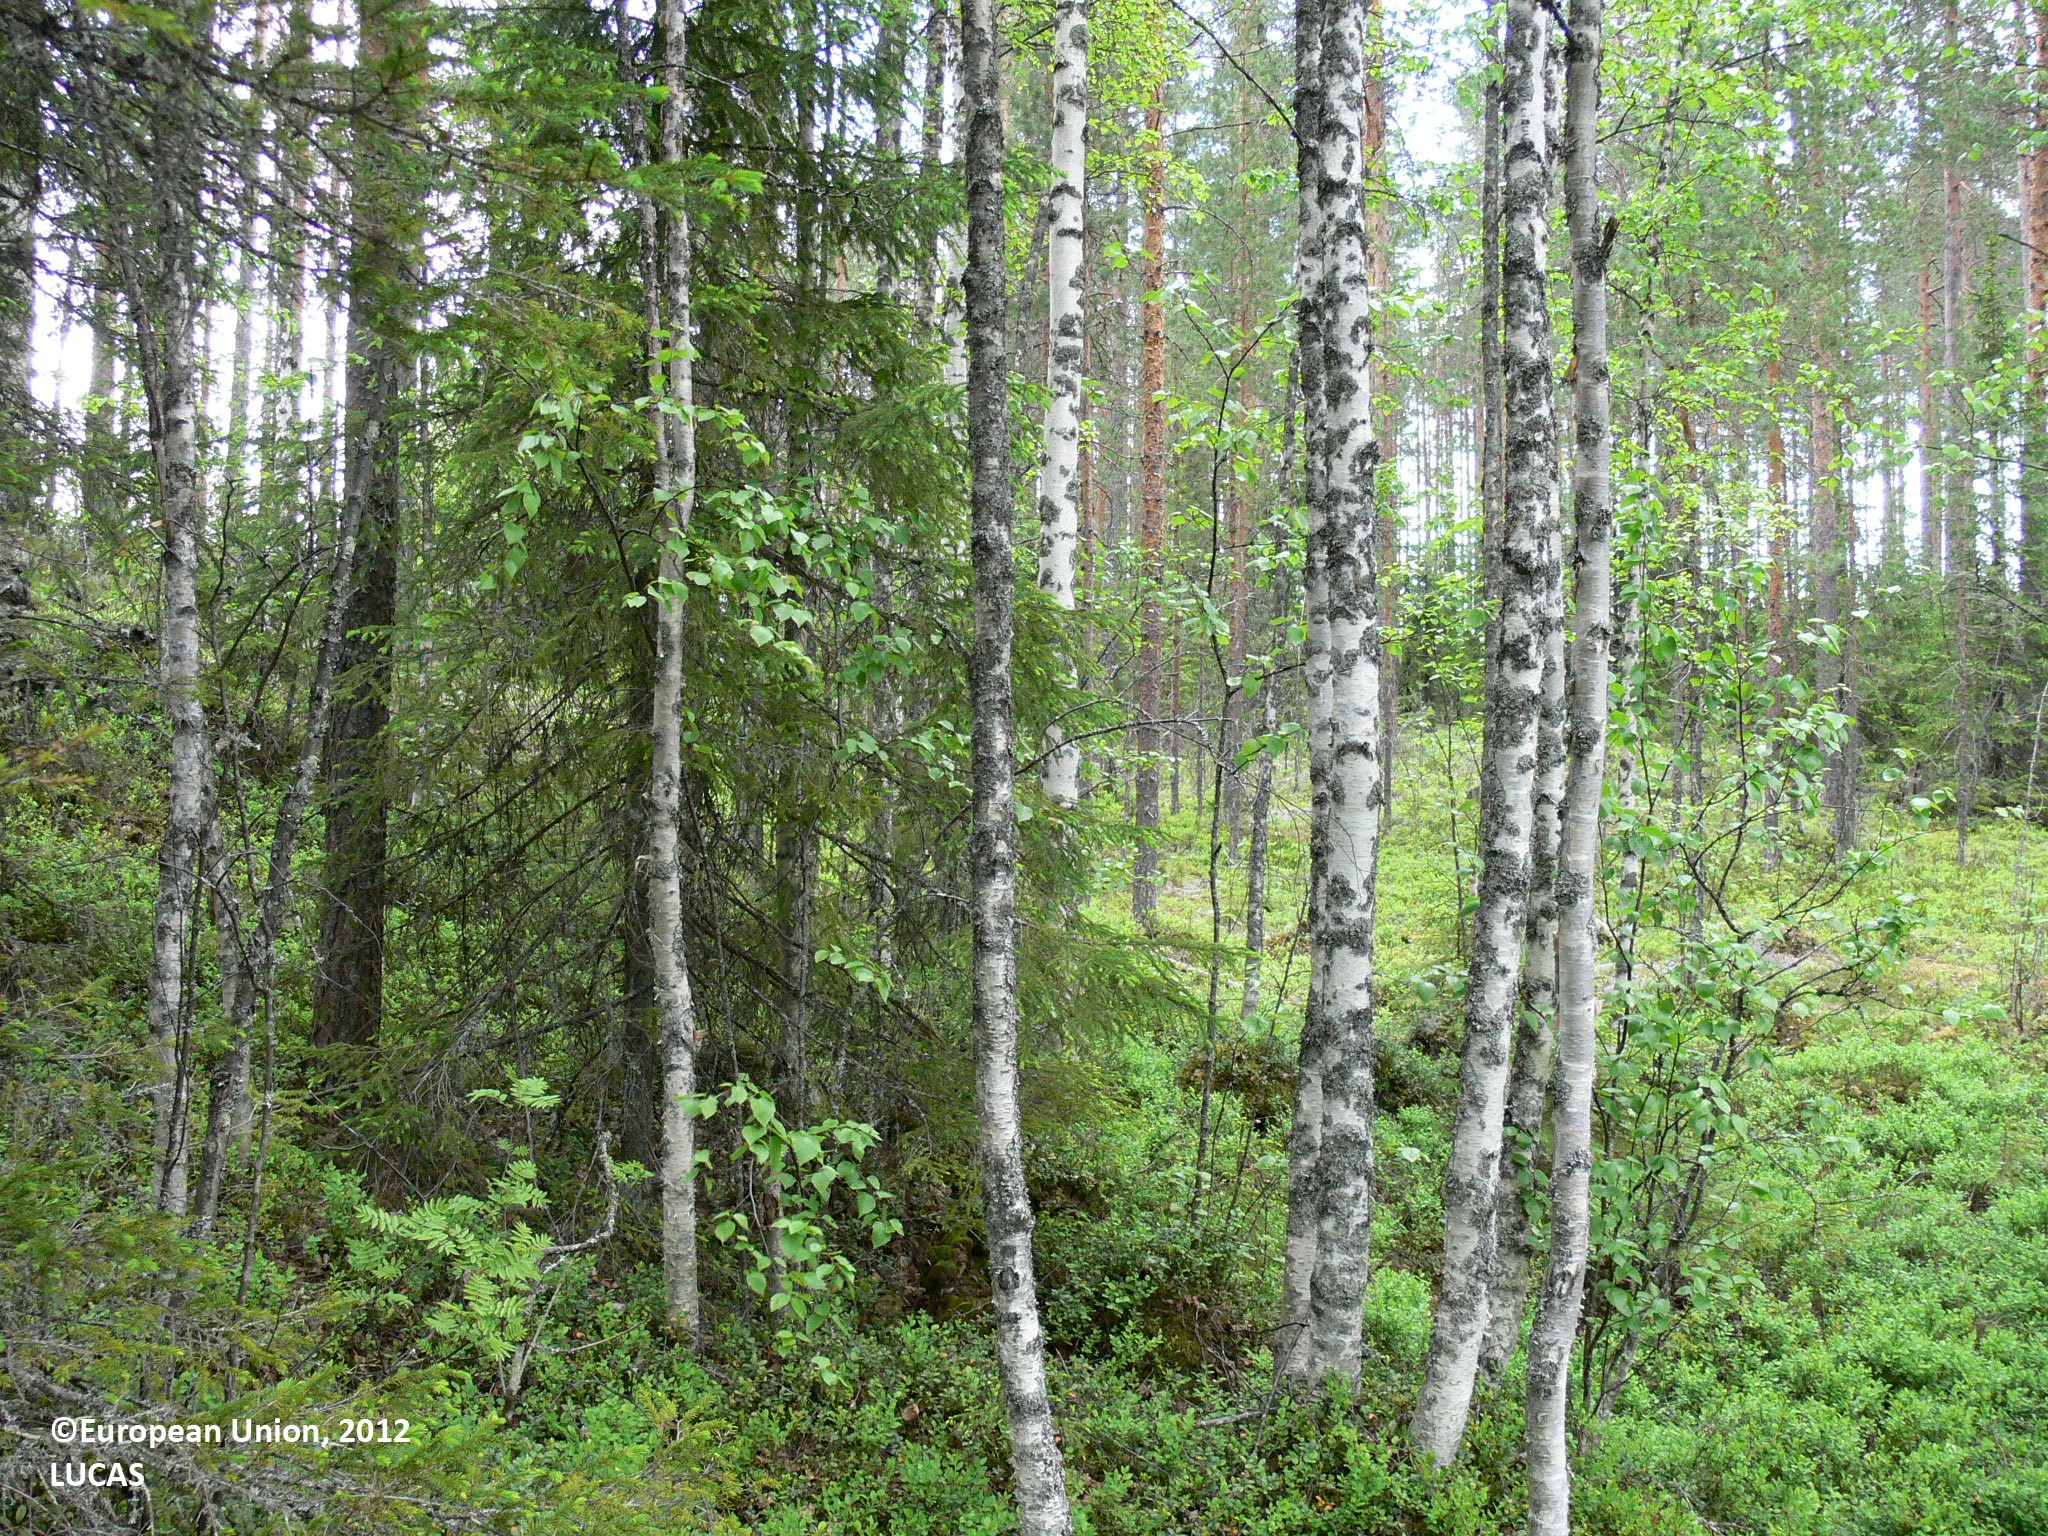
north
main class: Woodland
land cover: Other mixed woodland
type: boreal forest
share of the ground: > 75 %
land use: Forestry
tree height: > 5 m
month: June
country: FI
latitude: 62.6141
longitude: 30.4070
